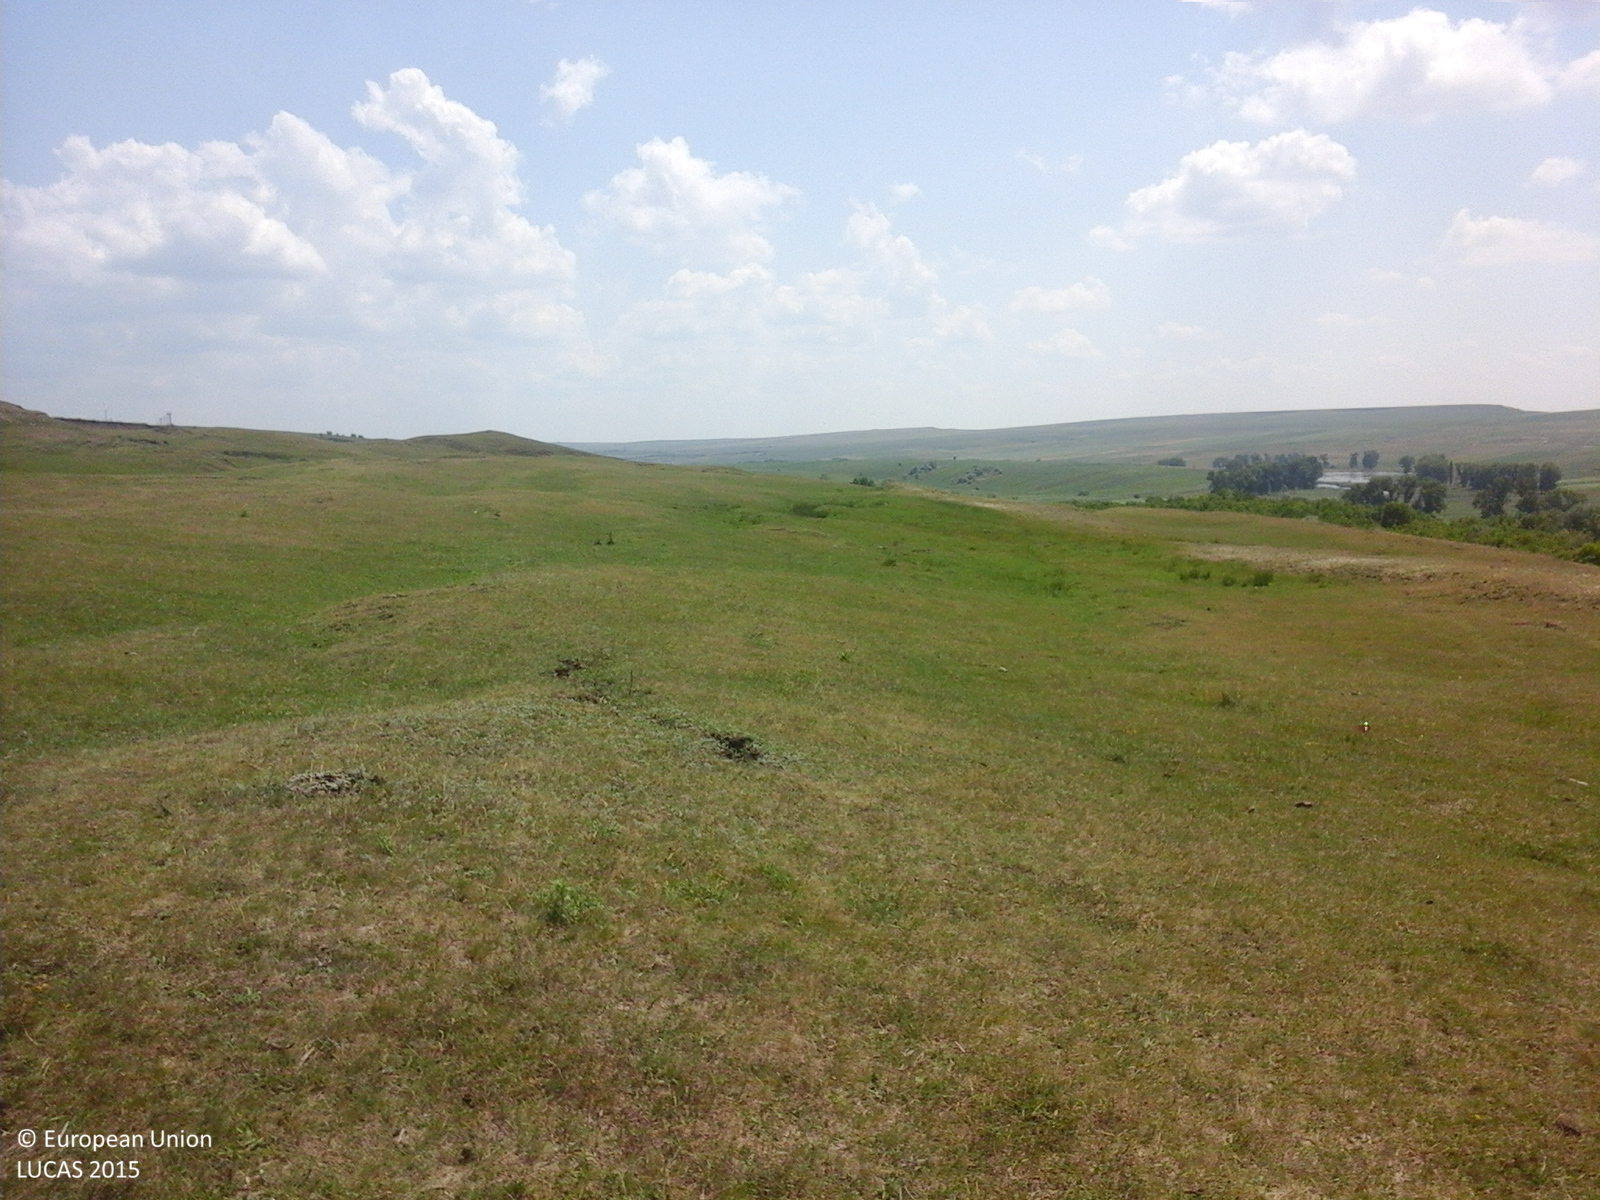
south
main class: Grassland
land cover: Grassland without tree/shrub cover
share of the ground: > 75 %
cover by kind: herbaceous plants 100 %
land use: Agriculture (excluding fallow land and kitchen gardens)
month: June
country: RO
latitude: 48.0375
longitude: 26.7162
